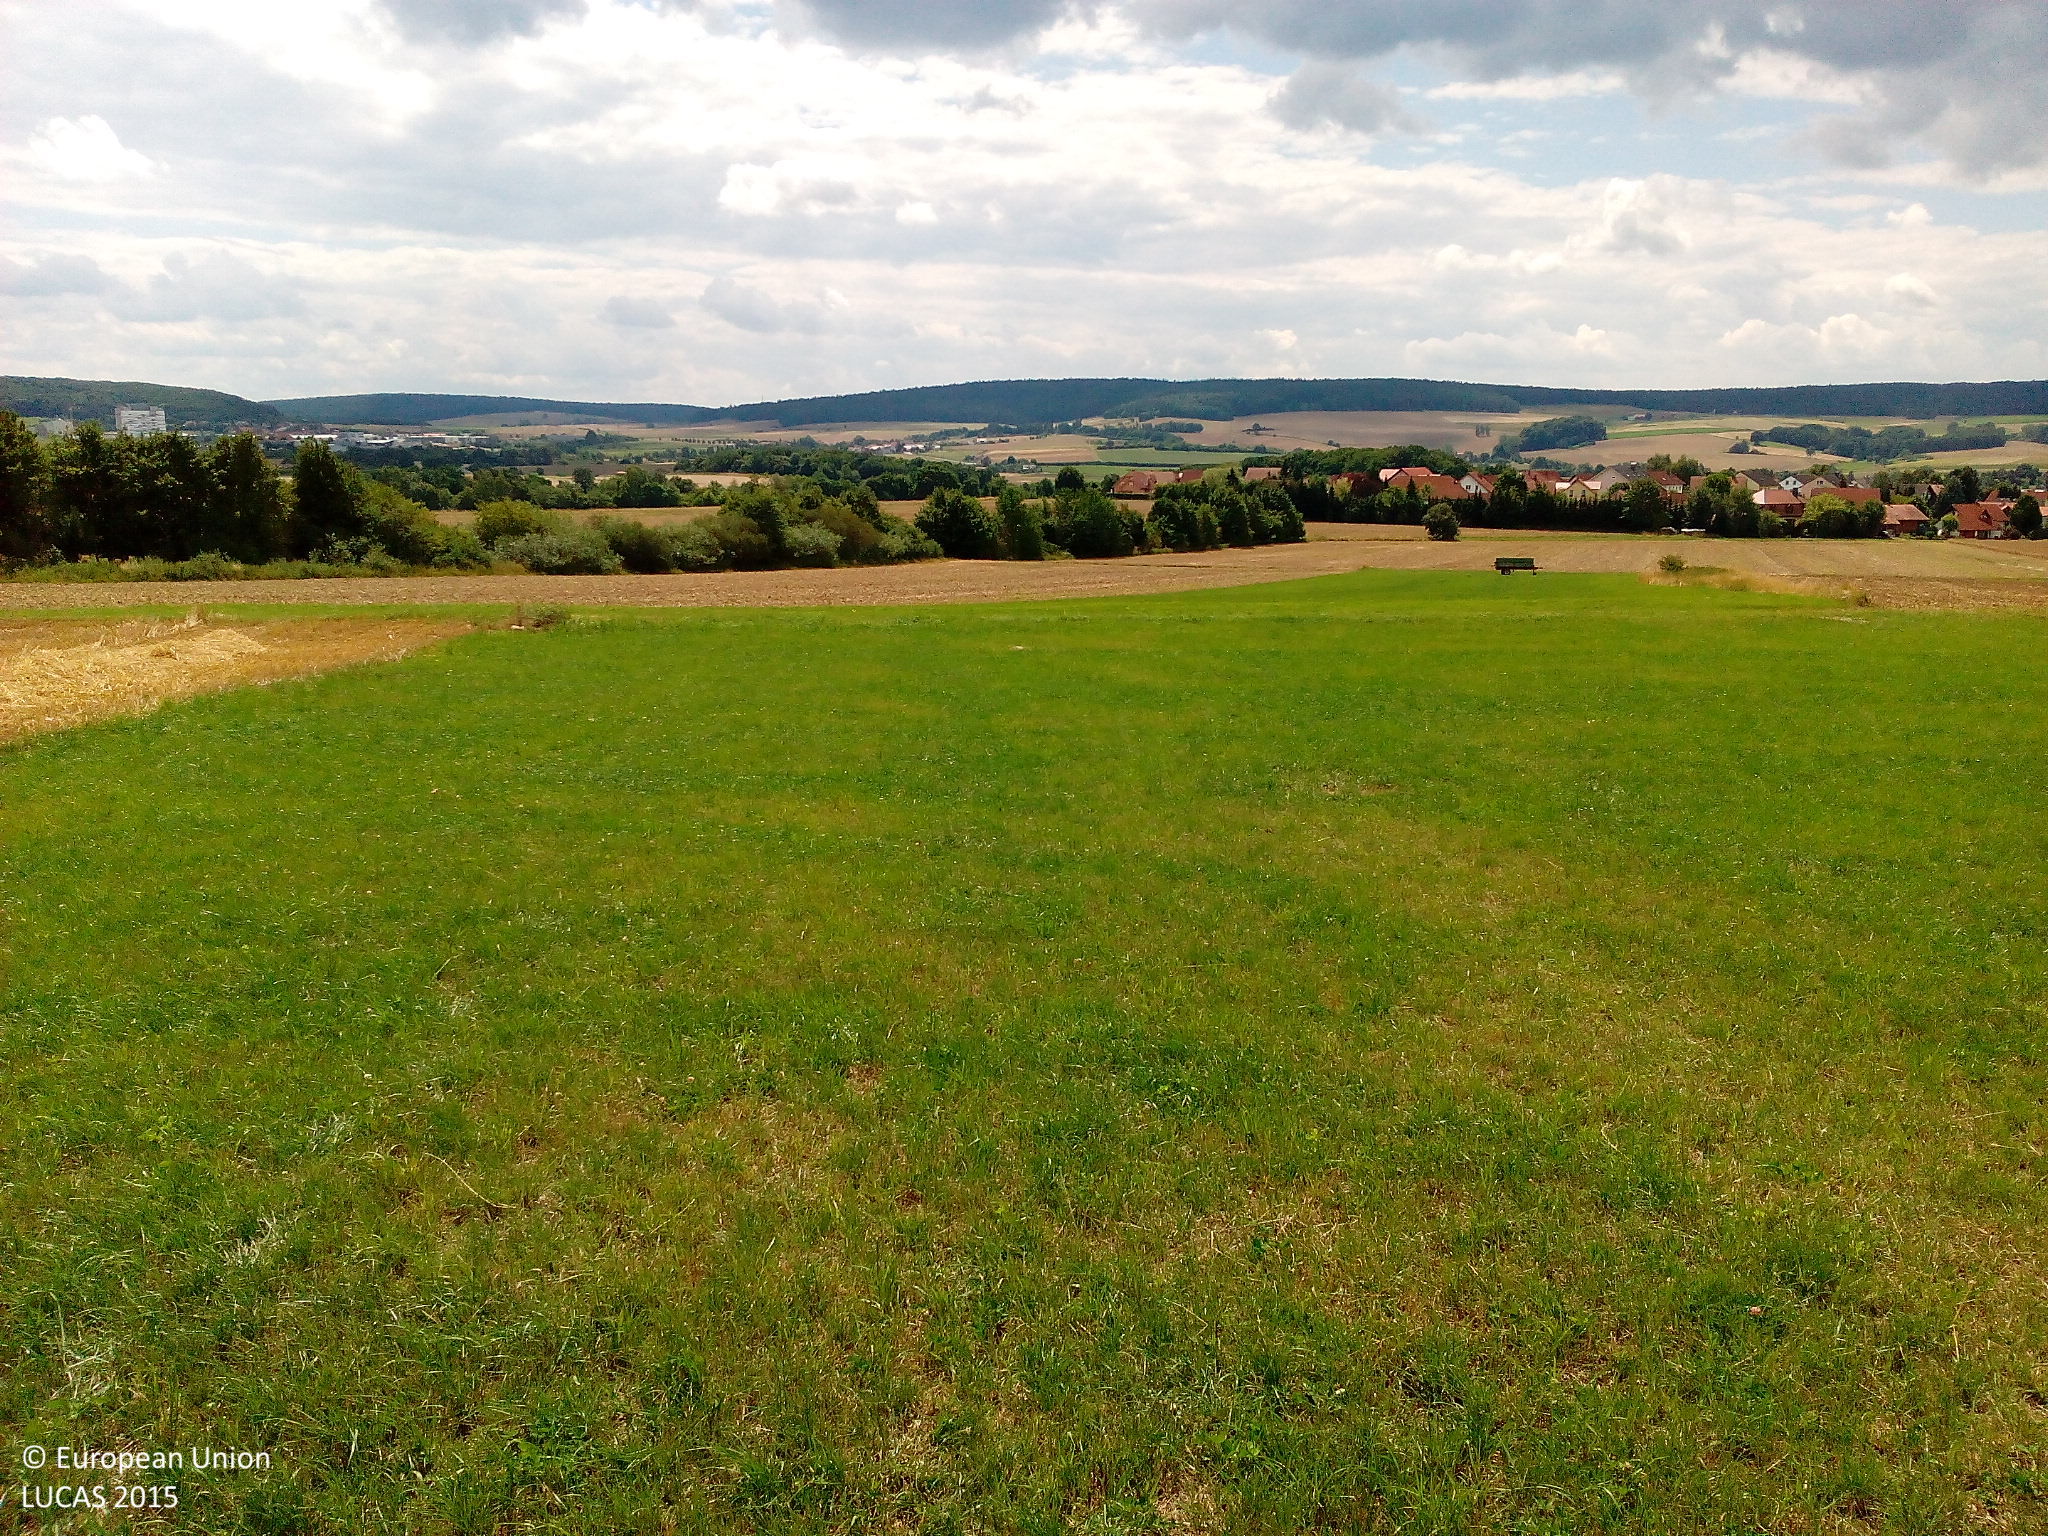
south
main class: Grassland
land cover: Grassland without tree/shrub cover
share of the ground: > 75 %
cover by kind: herbaceous plants 100 %
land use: Agriculture (excluding fallow land and kitchen gardens)
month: July
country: DE
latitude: 50.5791
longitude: 9.5906
